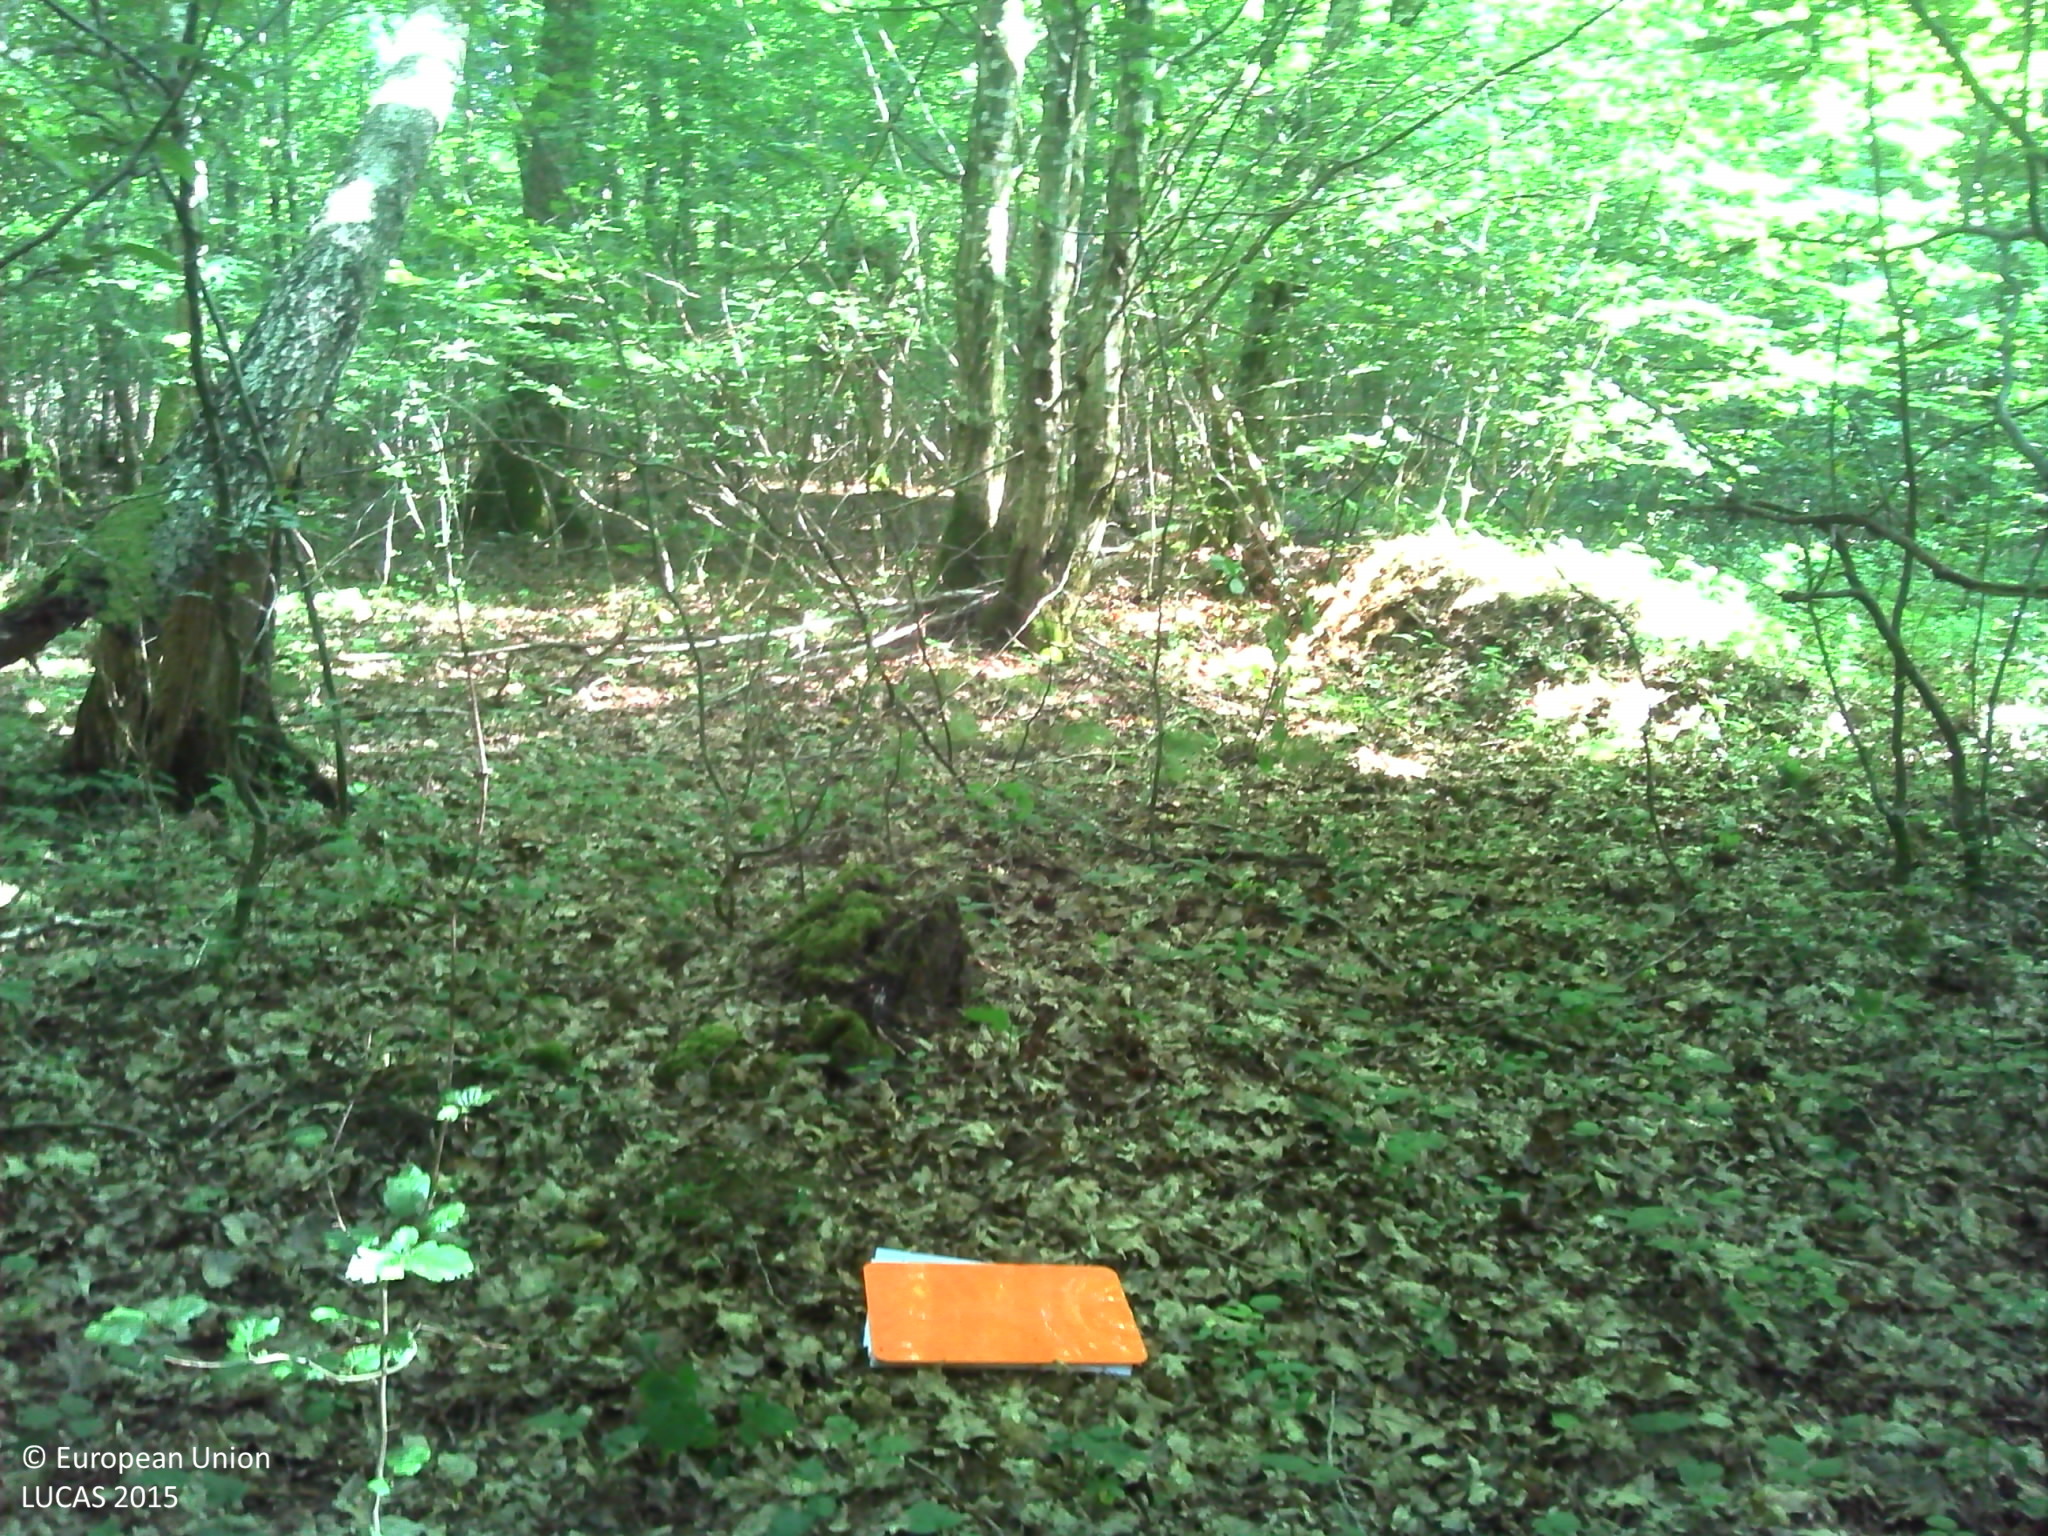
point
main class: Woodland
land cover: Broadleaved woodland
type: mesophytic deciduous forest
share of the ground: > 75 %
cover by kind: broadleaved forest trees 80 %, herbaceous plants 10 %, consolidated bare surface 10 %
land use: Forestry
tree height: > 5 m
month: July
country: FR
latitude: 48.9682
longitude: 1.1139
